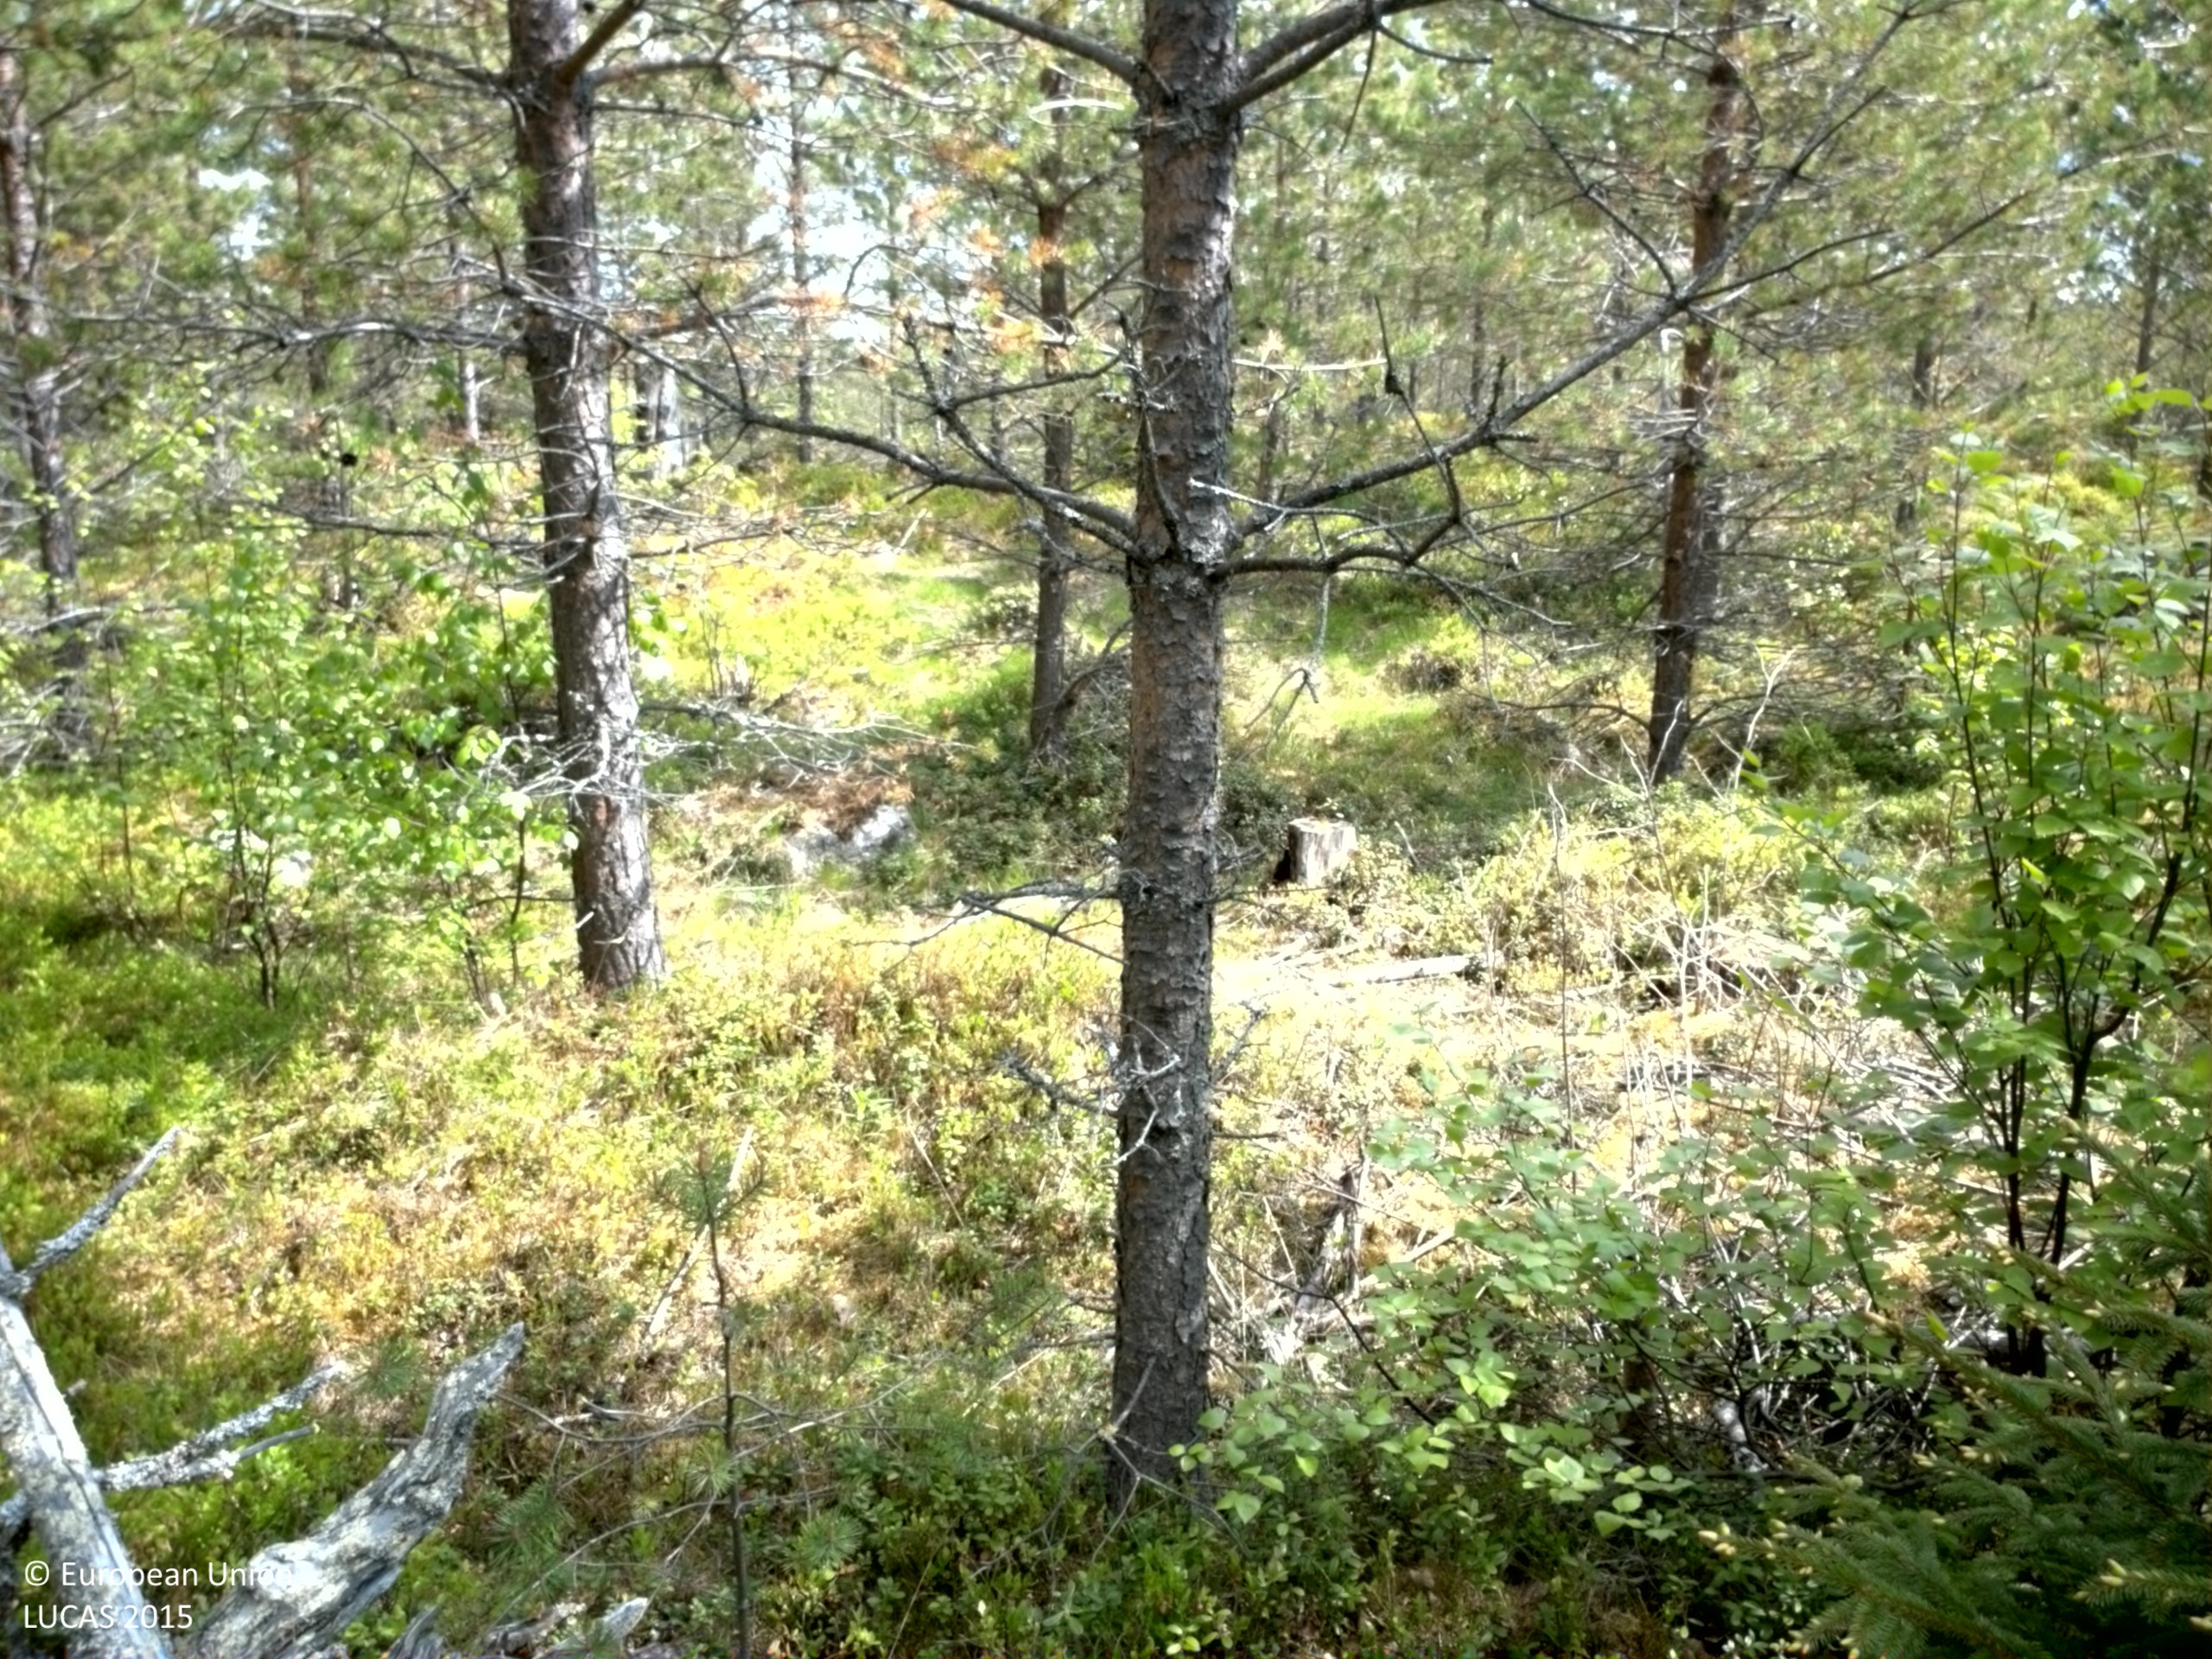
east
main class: Woodland
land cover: Pine dominated coniferous woodland
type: boreal forest
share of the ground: > 75 %
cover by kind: coniferous forest trees 85 %, shrubs 15 %
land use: Forestry
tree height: > 5 m
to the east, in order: Pine dominated coniferous woodland; Shrubland without tree cover; Spruce dominated mixed woodland; Pine dominated coniferous woodland
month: June
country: SE
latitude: 62.9757
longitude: 16.9799
